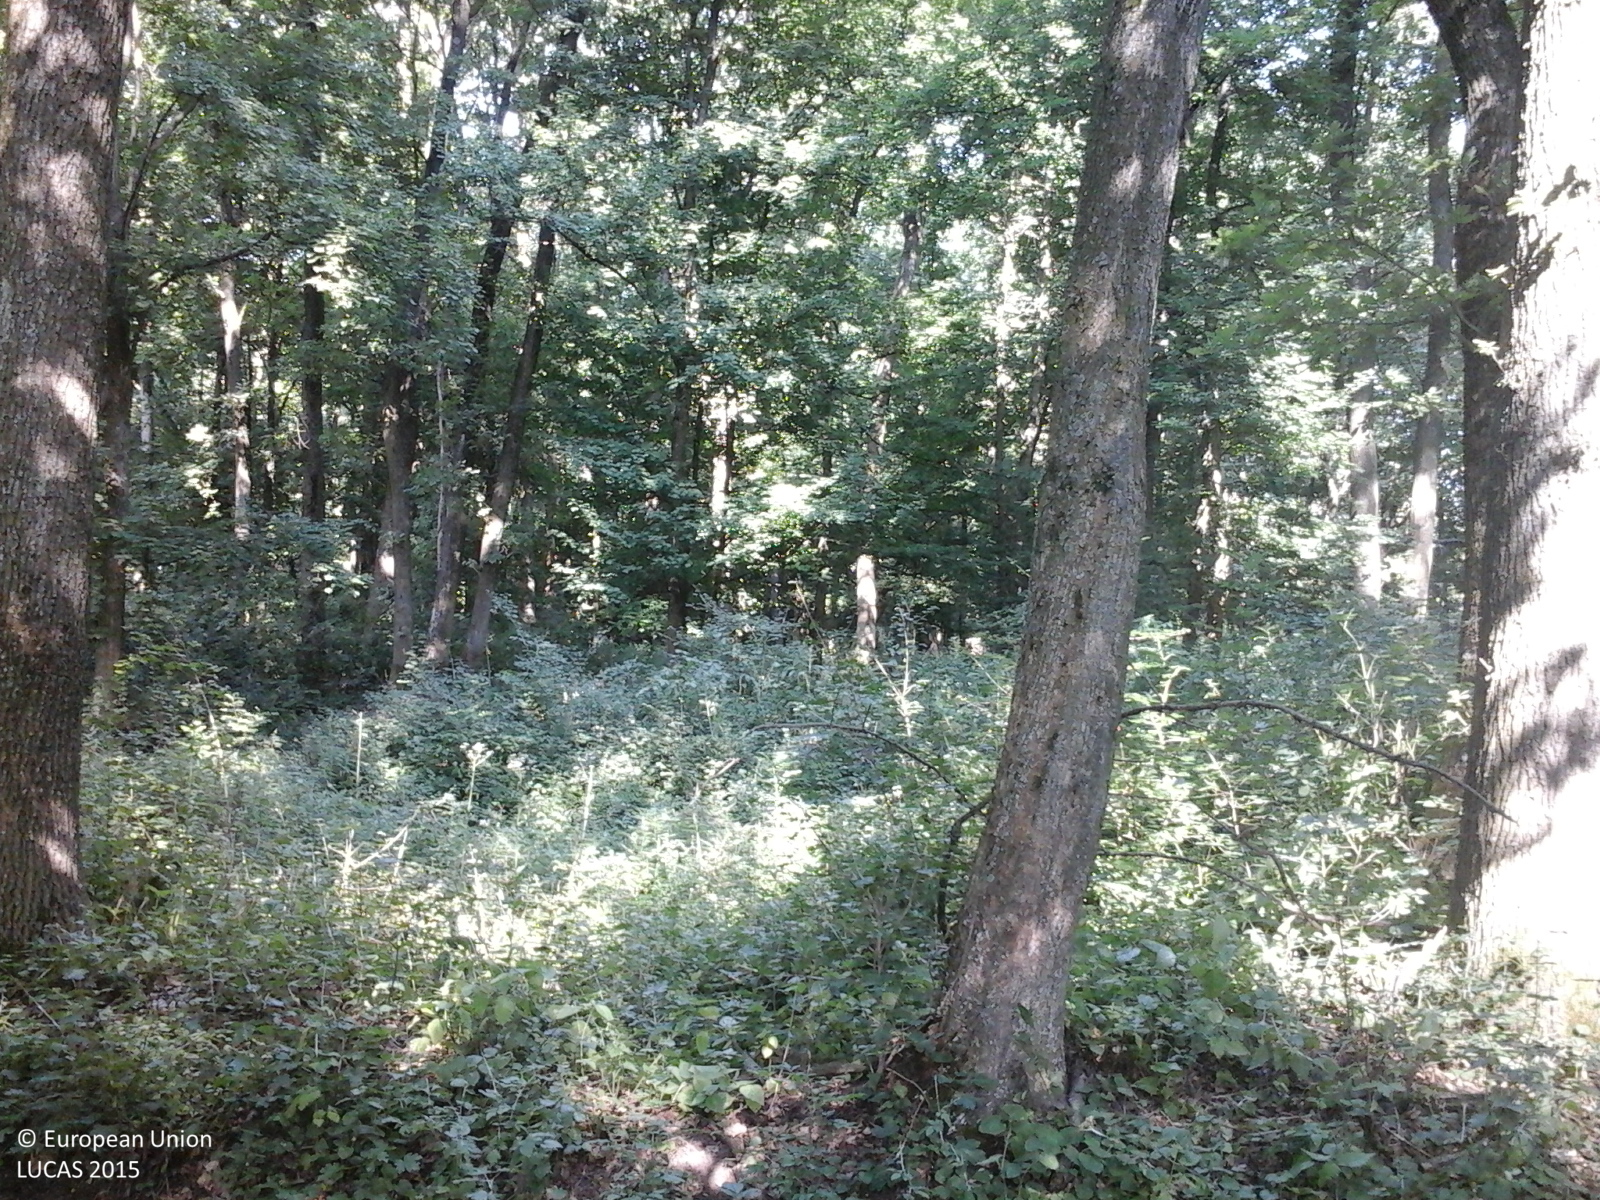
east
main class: Woodland
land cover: Broadleaved woodland
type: mesophytic deciduous forest
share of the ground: > 75 %
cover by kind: broadleaved forest trees 85 %, herbaceous plants 10 %, shrubs 5 %
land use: Forestry
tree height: > 5 m
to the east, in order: Broadleaved woodland
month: June
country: RO
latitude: 44.5300
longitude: 26.1254
